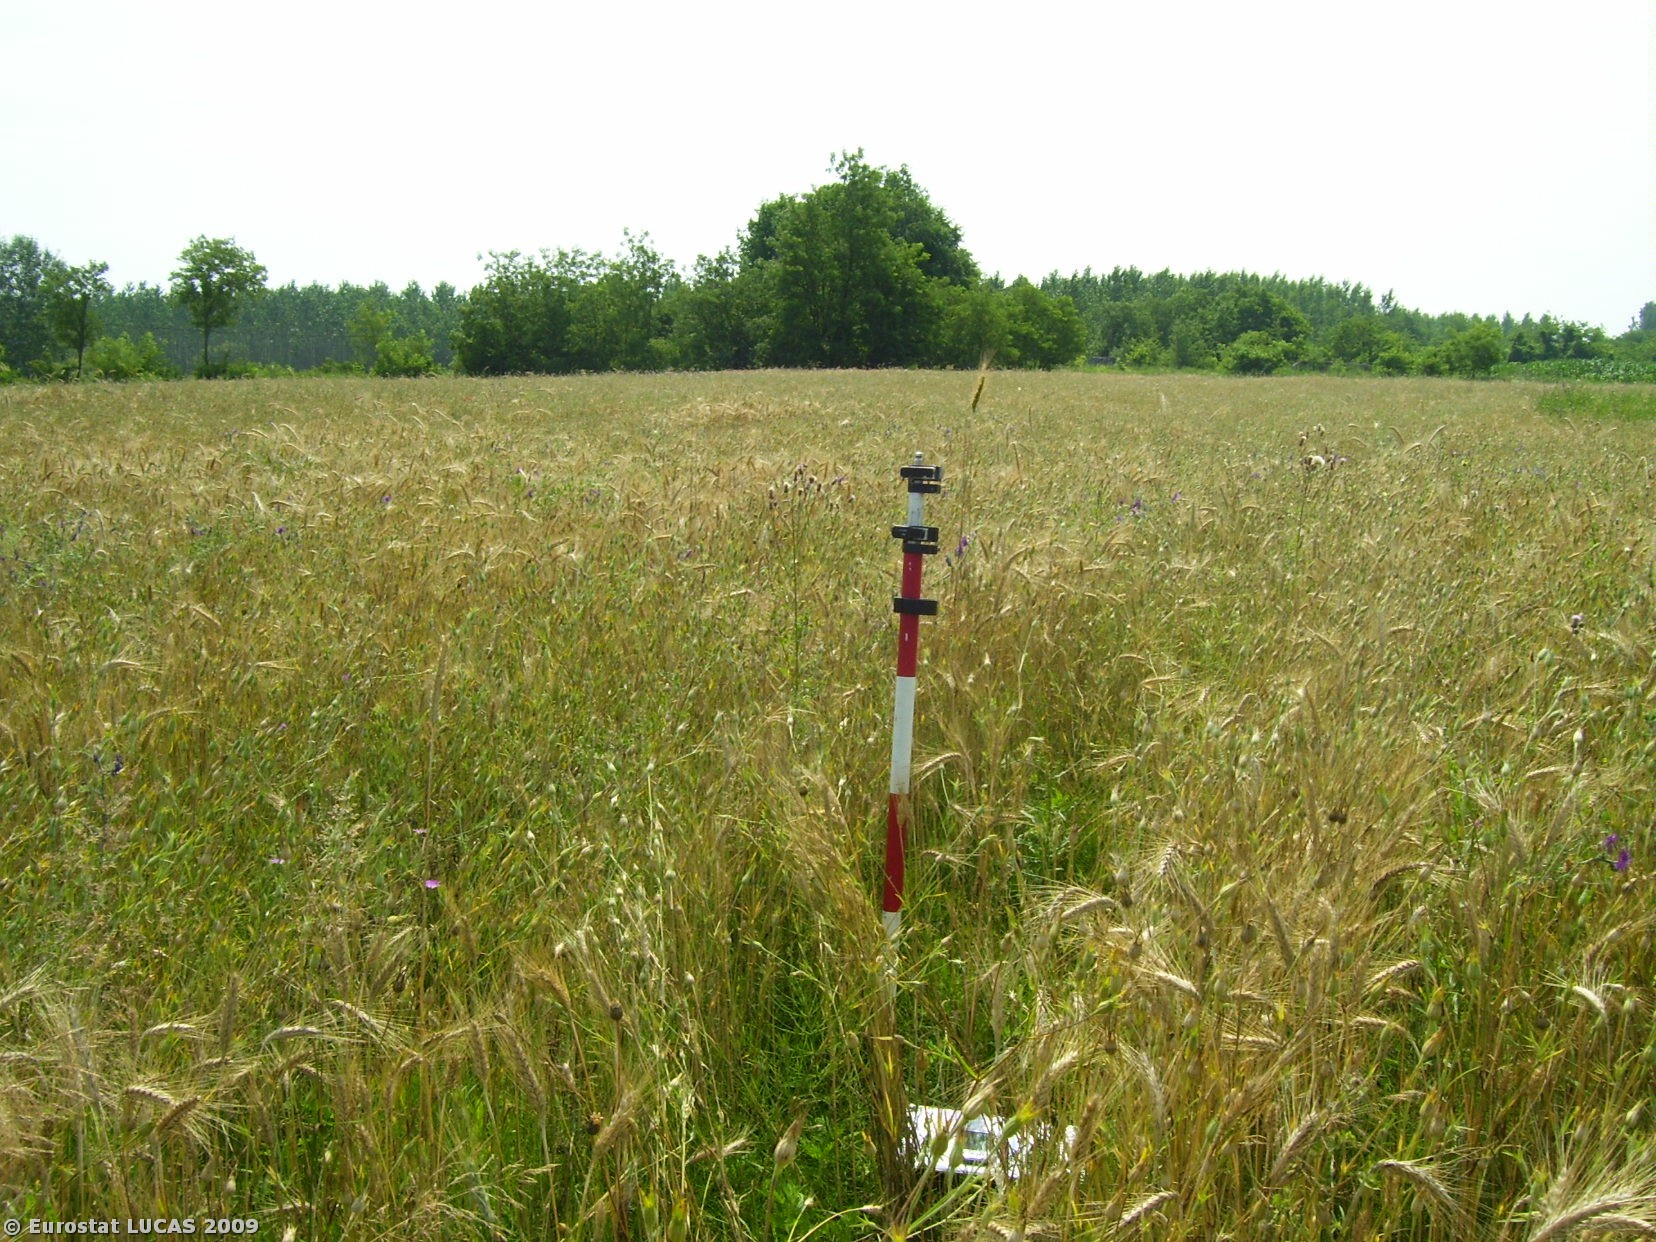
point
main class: Cropland
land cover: Triticale
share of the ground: 50 - 75 %
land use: Agriculture (excluding fallow land and kitchen gardens)
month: July
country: HU
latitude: 47.6211
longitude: 21.8233
